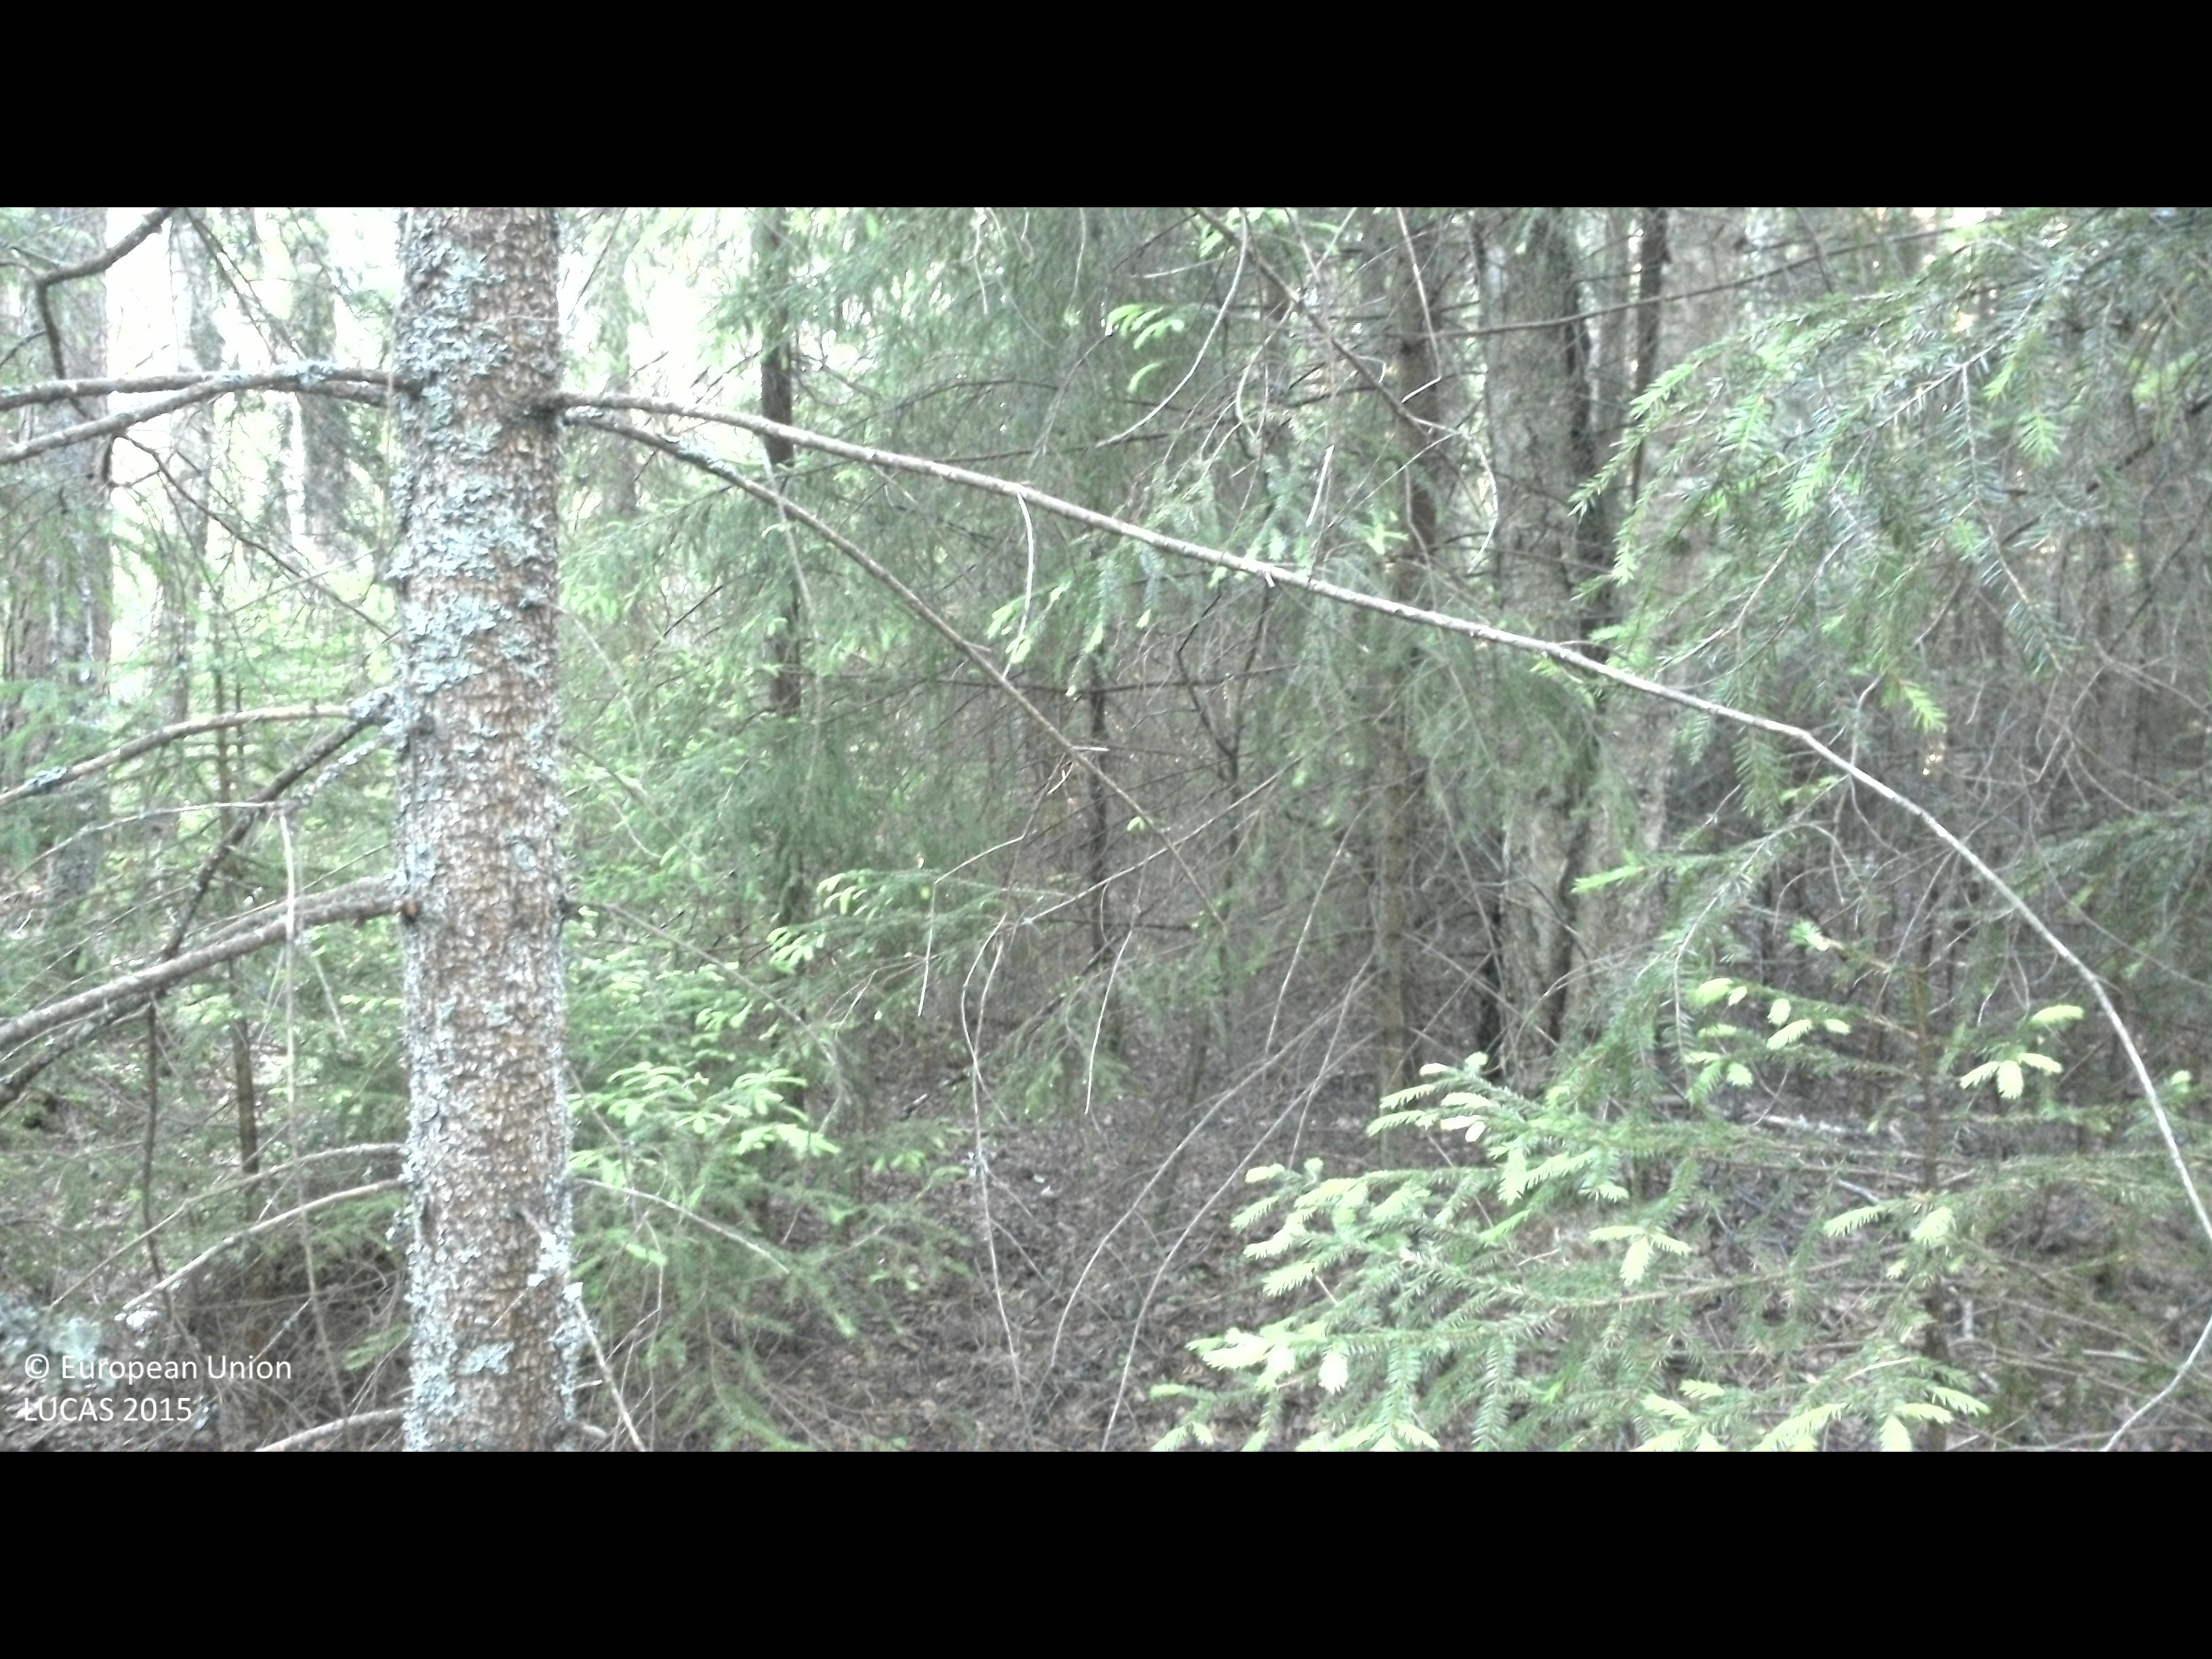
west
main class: Woodland
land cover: Spruce dominated coniferous woodland
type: boreal forest
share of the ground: > 75 %
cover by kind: coniferous forest trees 85 %, broadleaved forest trees 5 %, shrubs 5 %, lichens and mosses 5 %
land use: Forestry
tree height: > 5 m
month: July
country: SE
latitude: 56.4849
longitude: 15.0485
